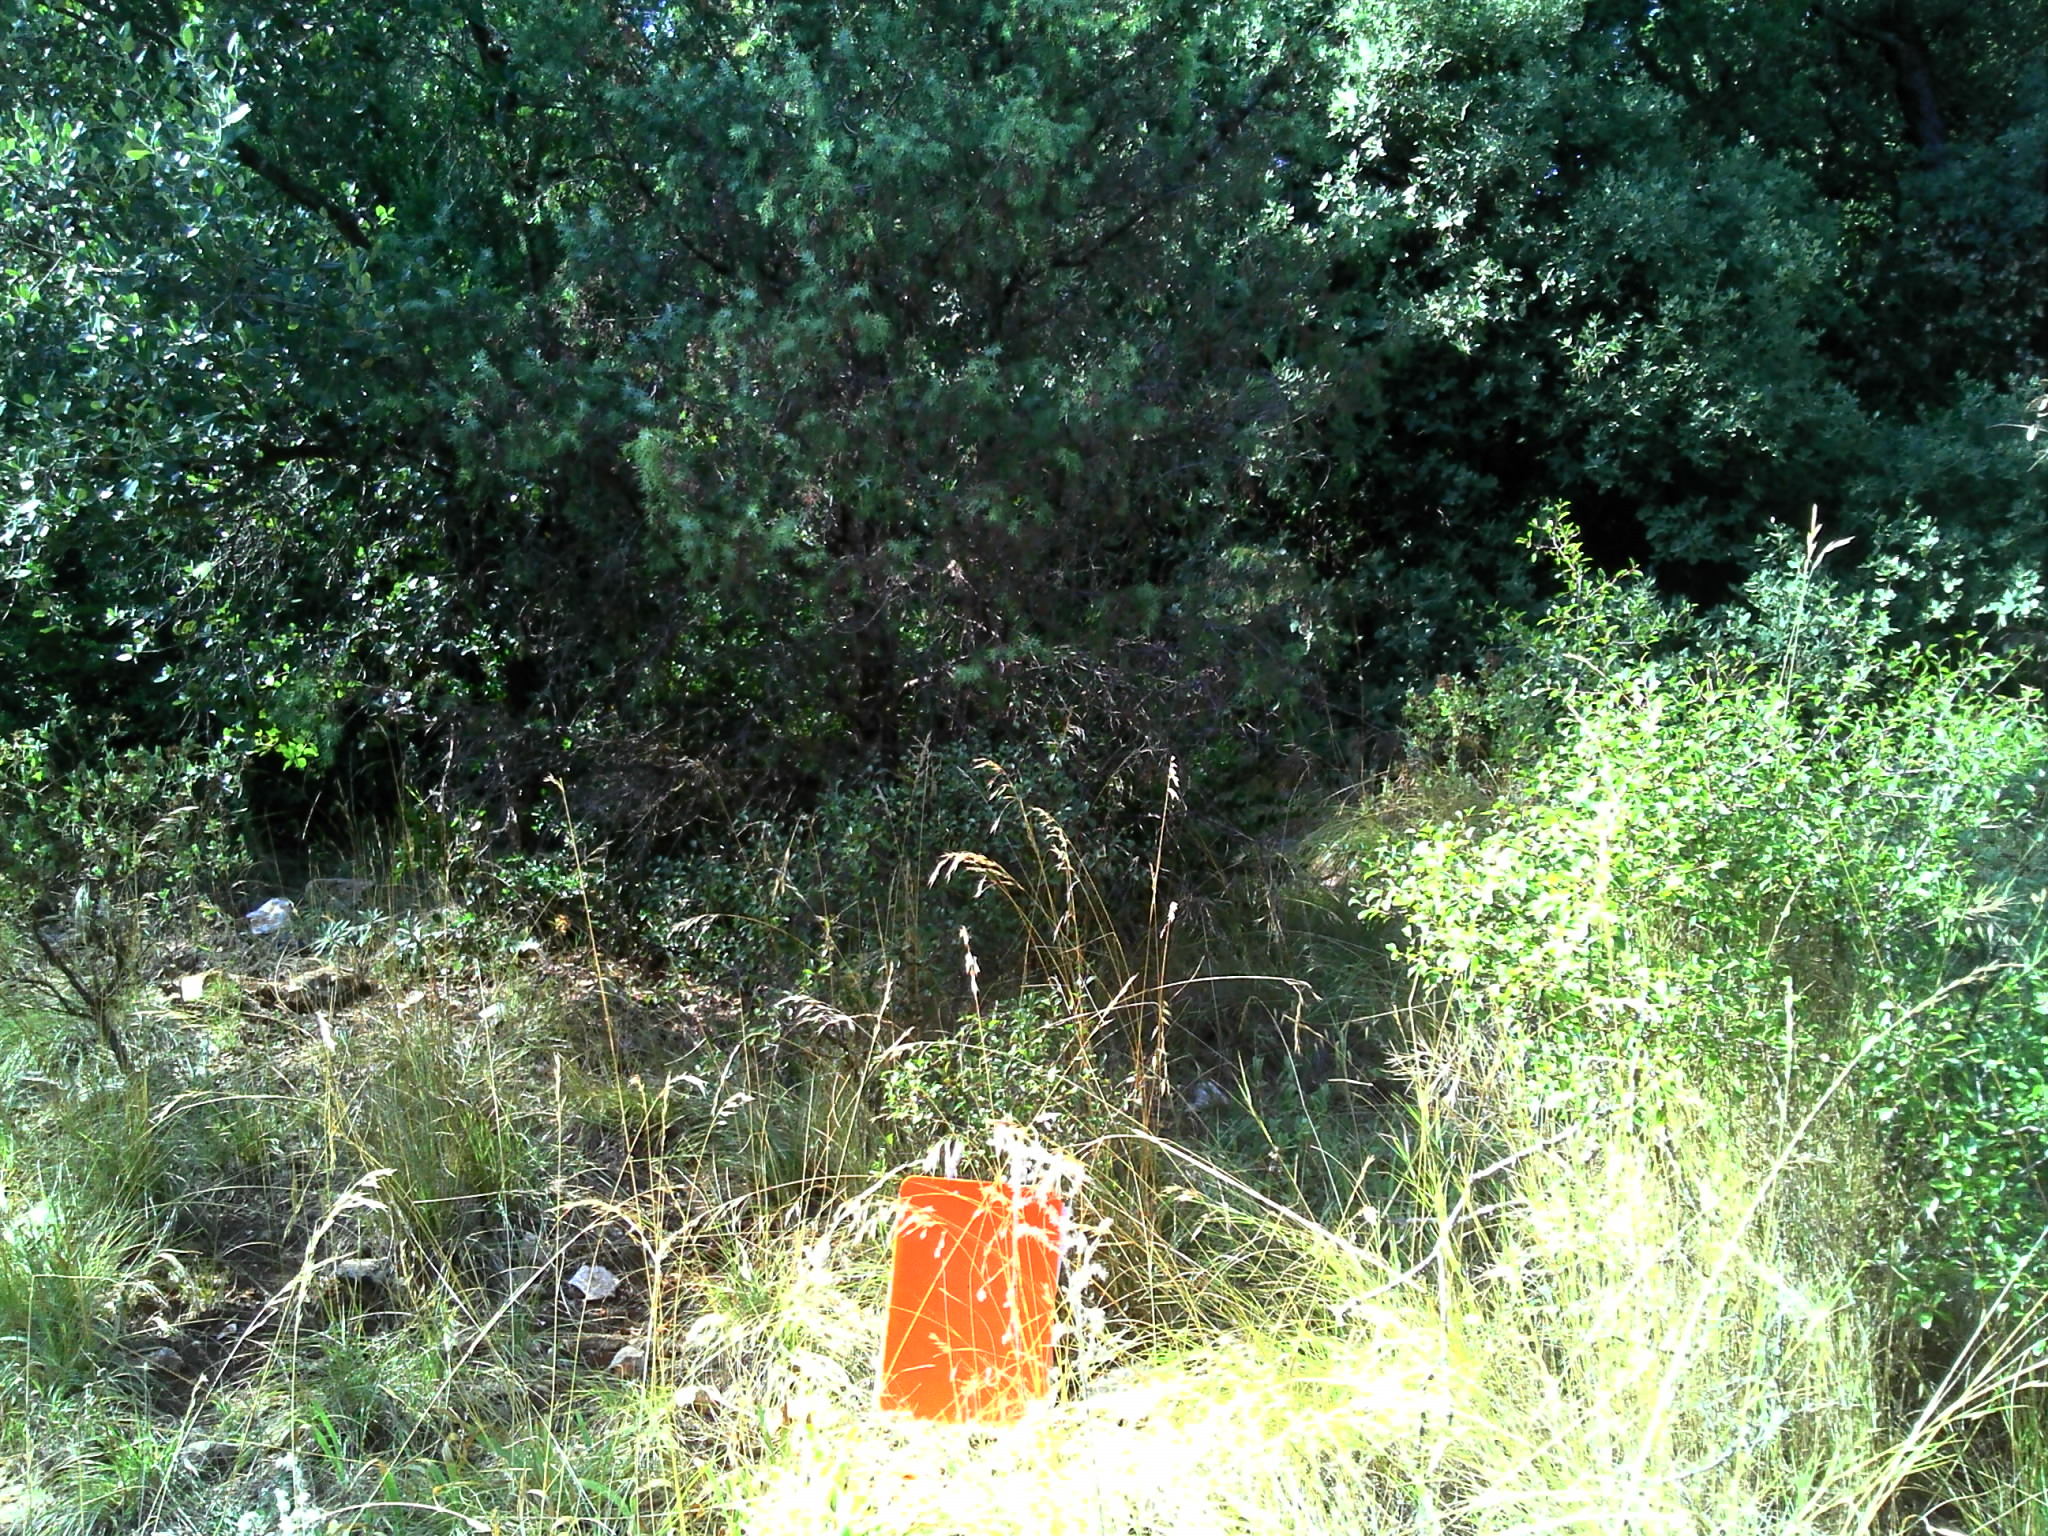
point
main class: Woodland
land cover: Pine dominated mixed woodland
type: coniferous forest of the mediterranean region
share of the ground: > 75 %
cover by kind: broadleaved forest trees 40 %, coniferous forest trees 30 %, herbaceous plants 20 %, shrubs 5 %, consolidated bare surface 5 %
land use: Semi-natural and natural areas not in use
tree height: > 5 m
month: August
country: FR
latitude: 44.0308
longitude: 4.6305
